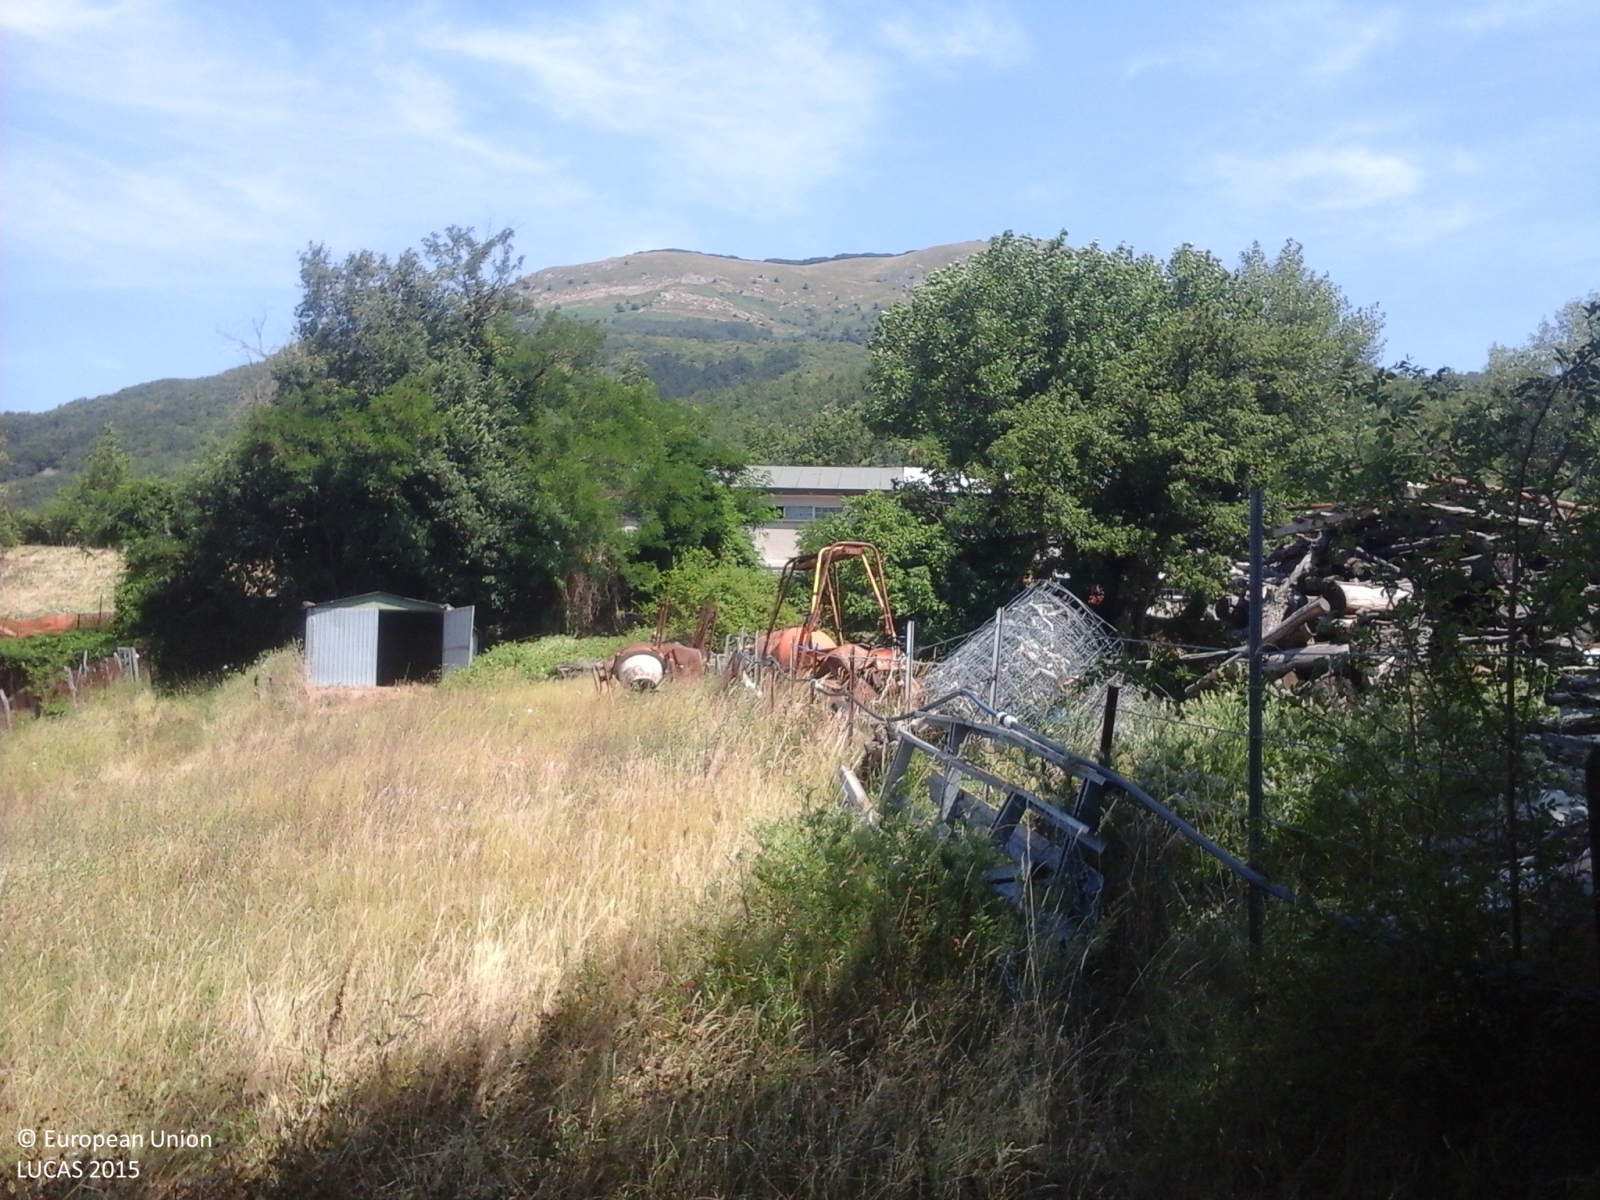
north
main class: Woodland
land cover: Broadleaved woodland
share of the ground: > 75 %
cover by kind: broadleaved forest trees 85 %
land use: Agriculture (excluding fallow land and kitchen gardens)
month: July
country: IT
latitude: 44.3501
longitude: 10.2879
